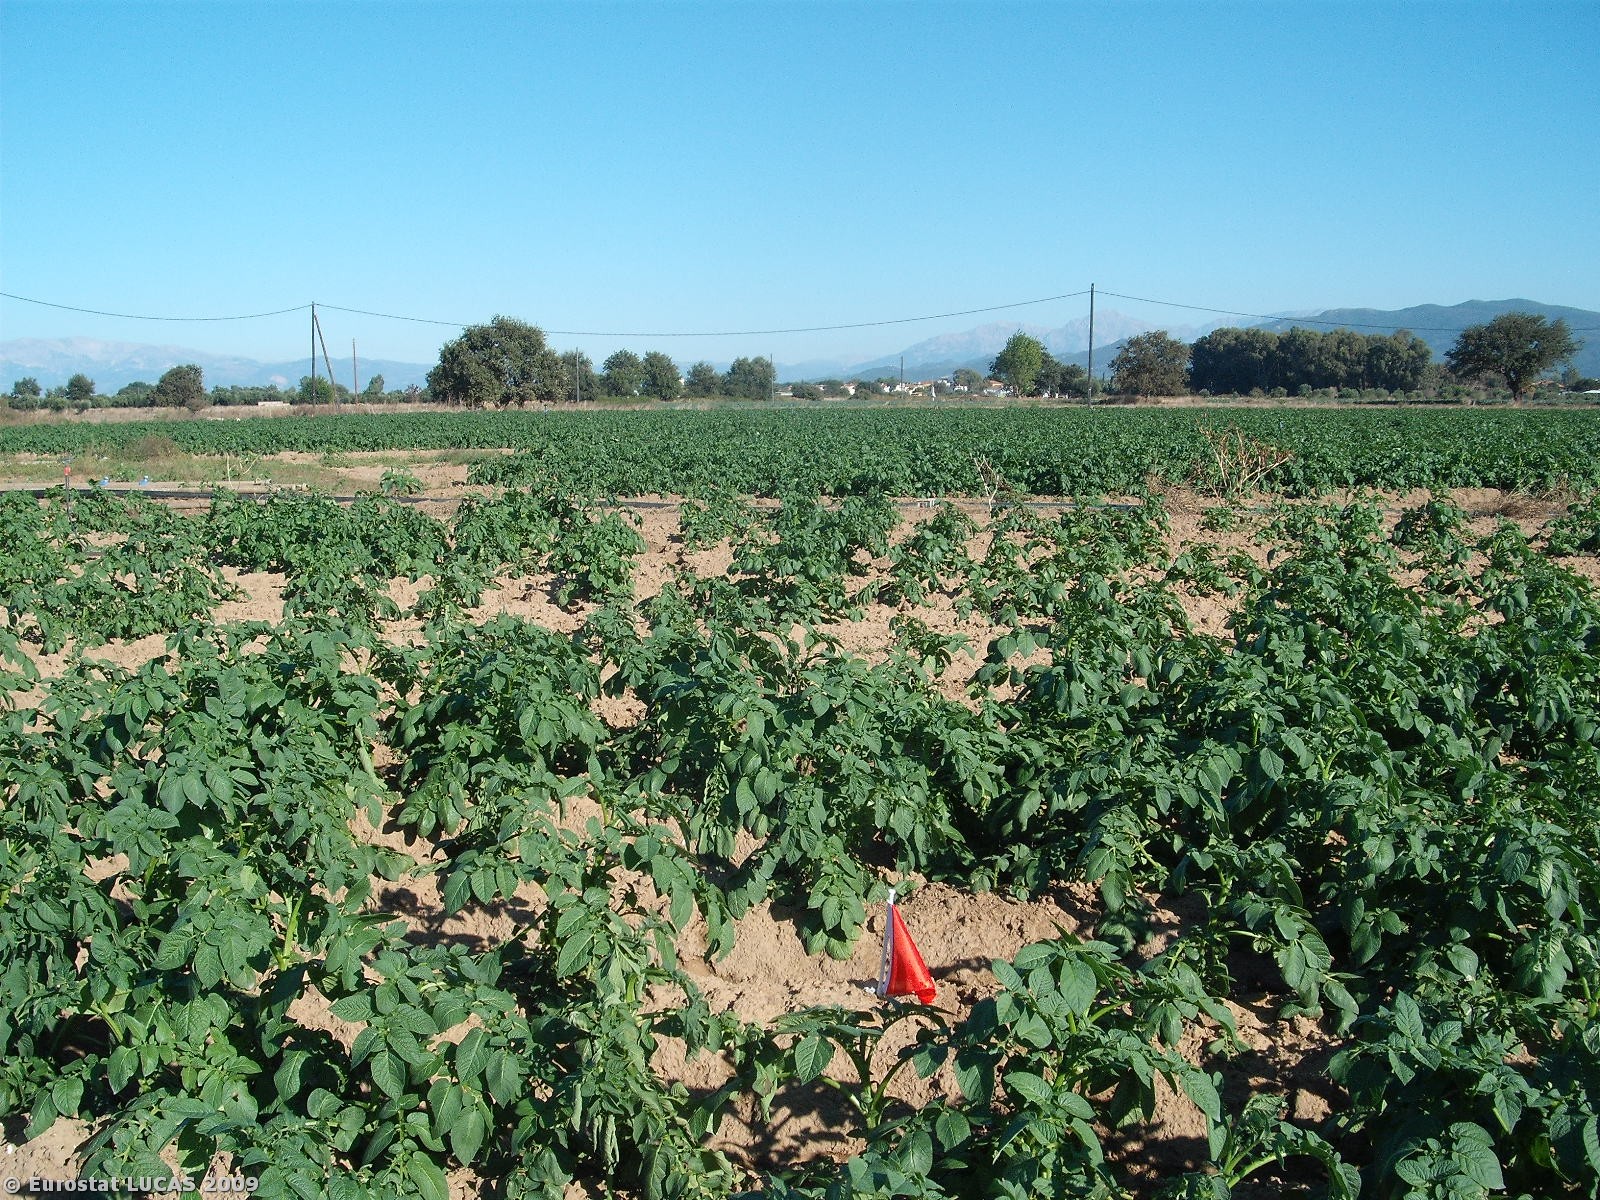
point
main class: Cropland
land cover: Potatoes
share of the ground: 50 - 75 %
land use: Agriculture (excluding fallow land and kitchen gardens)
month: October
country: GR
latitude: 38.1021
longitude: 21.4018
